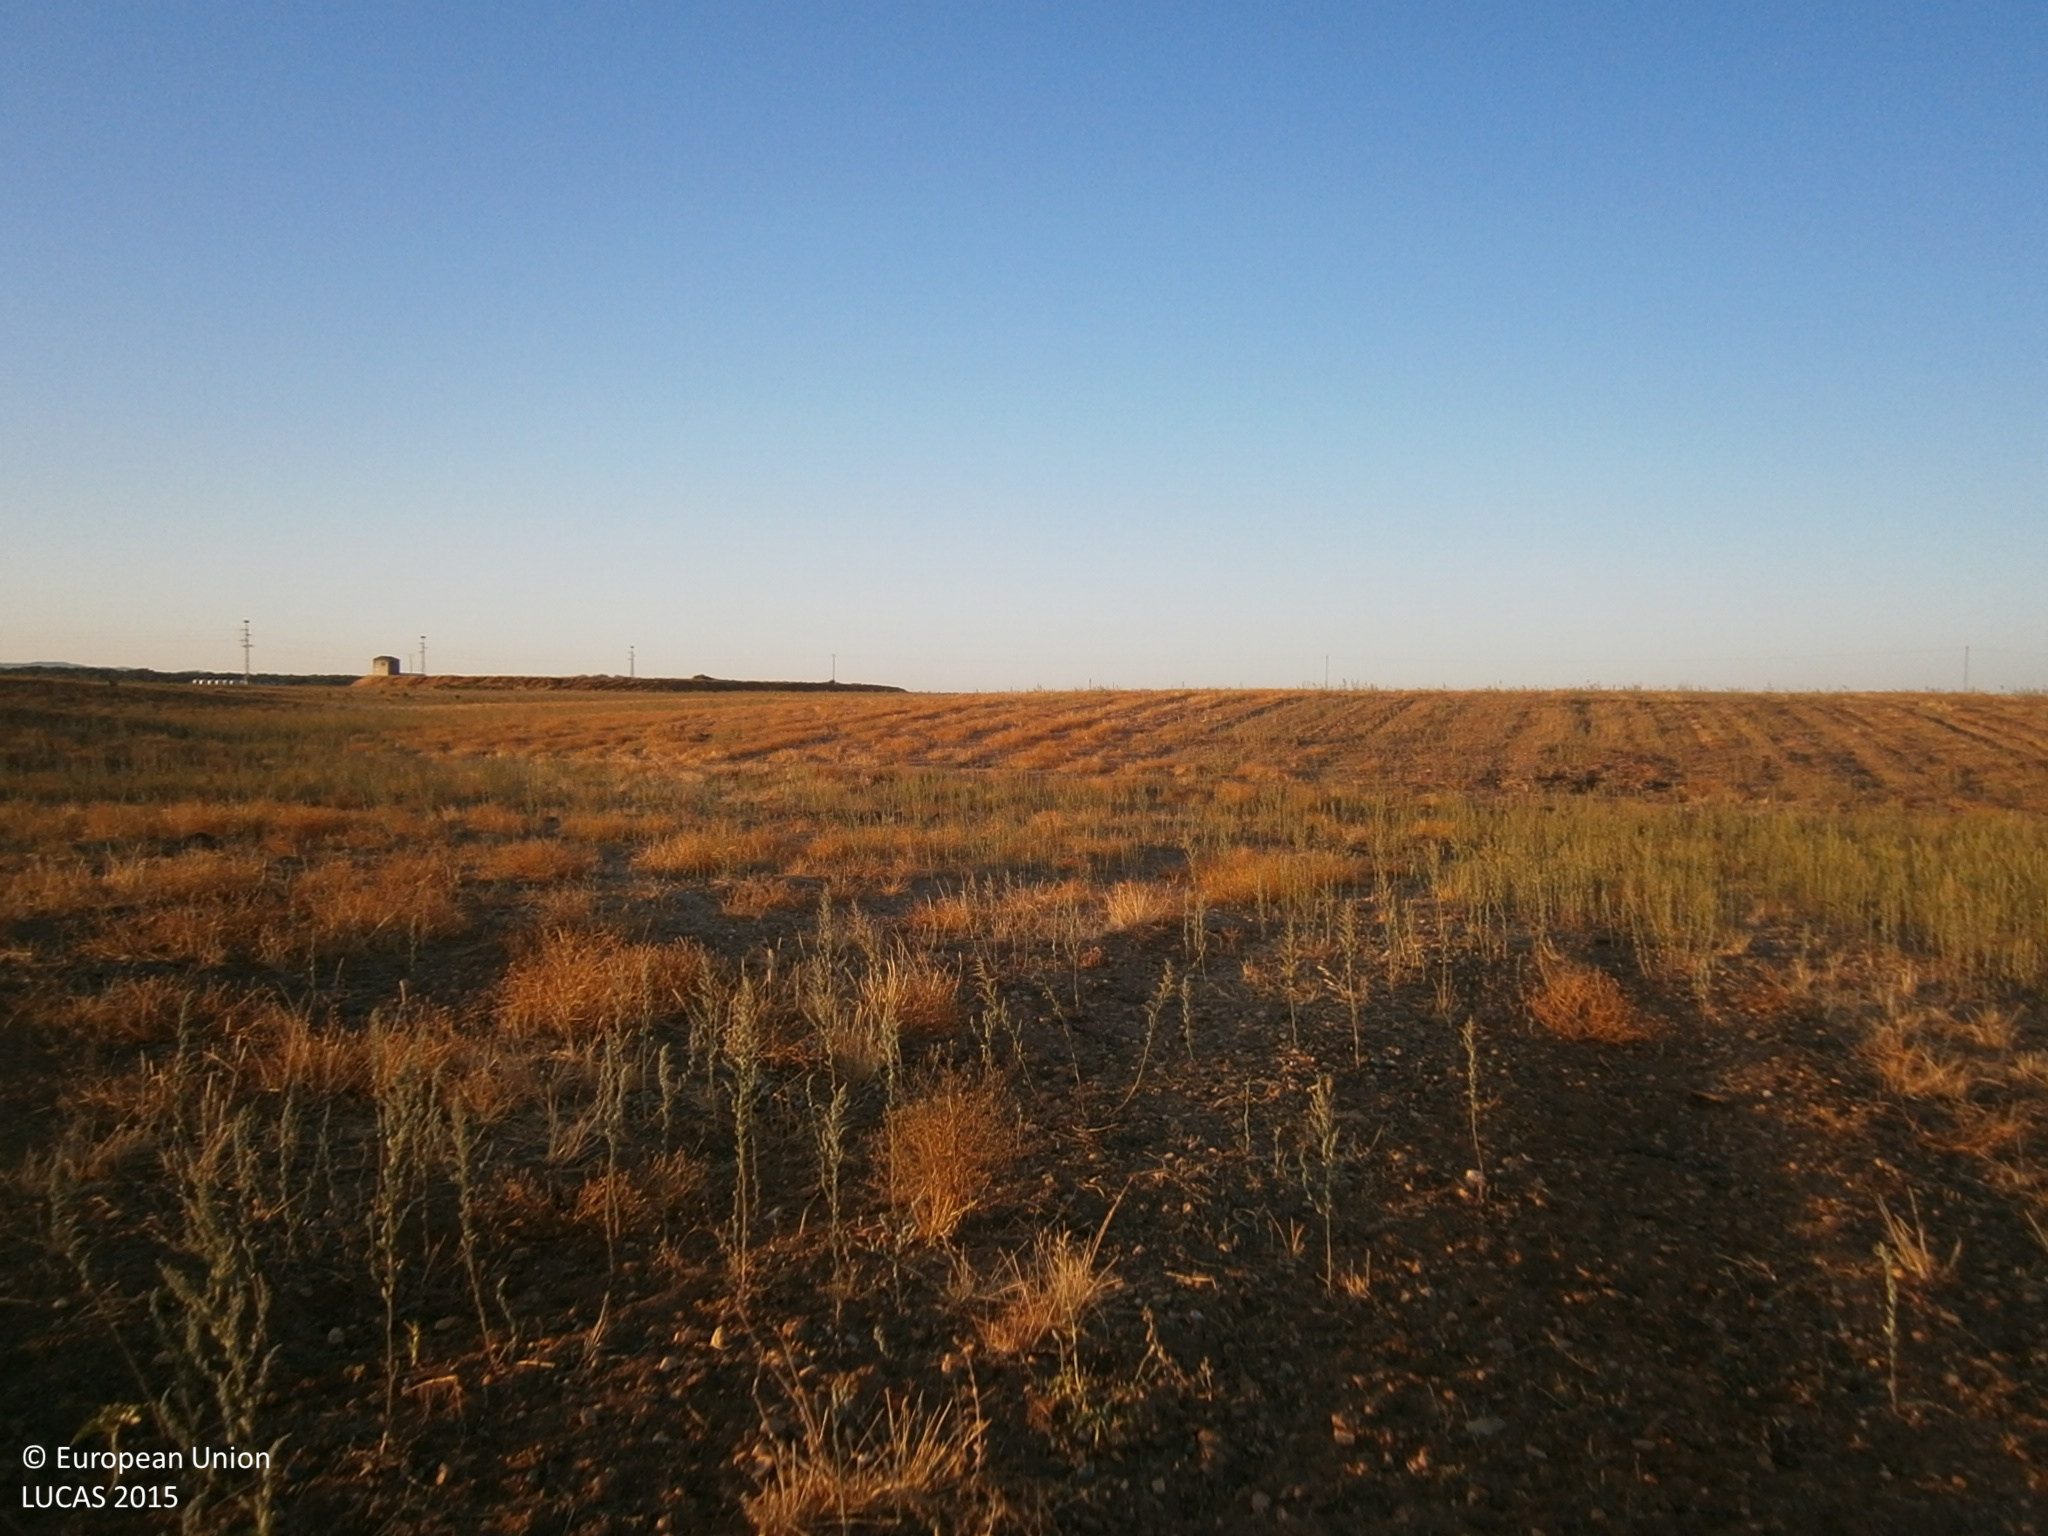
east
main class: Grassland
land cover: Spontaneously vegetated surfaces
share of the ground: > 75 %
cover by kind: herbaceous plants 80 %, unconsolidated bare surface 15 %
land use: Agriculture (excluding fallow land and kitchen gardens)
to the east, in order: Spontaneously vegetated surfaces
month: July
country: ES
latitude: 38.6782
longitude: -7.2100
